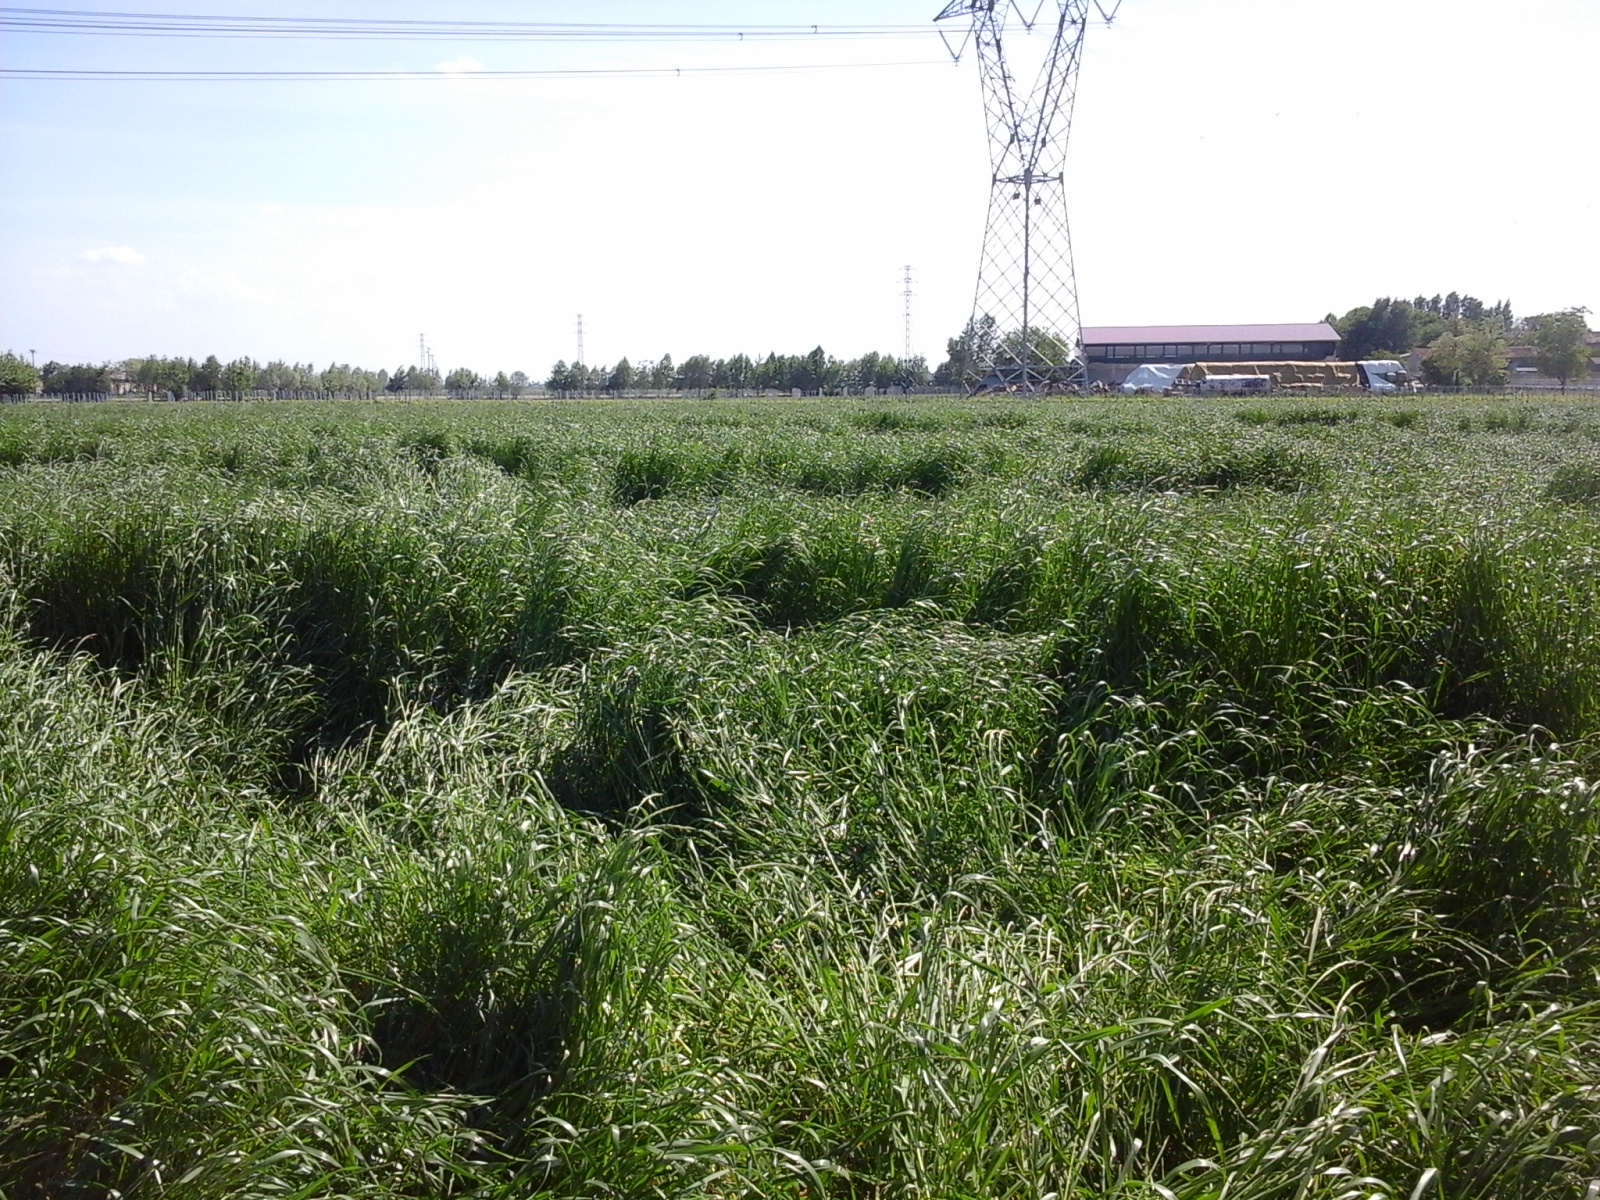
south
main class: Cropland
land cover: Temporary grasslands
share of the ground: > 75 %
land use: Agriculture (excluding fallow land and kitchen gardens)
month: May
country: IT
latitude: 45.3666
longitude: 11.5677
